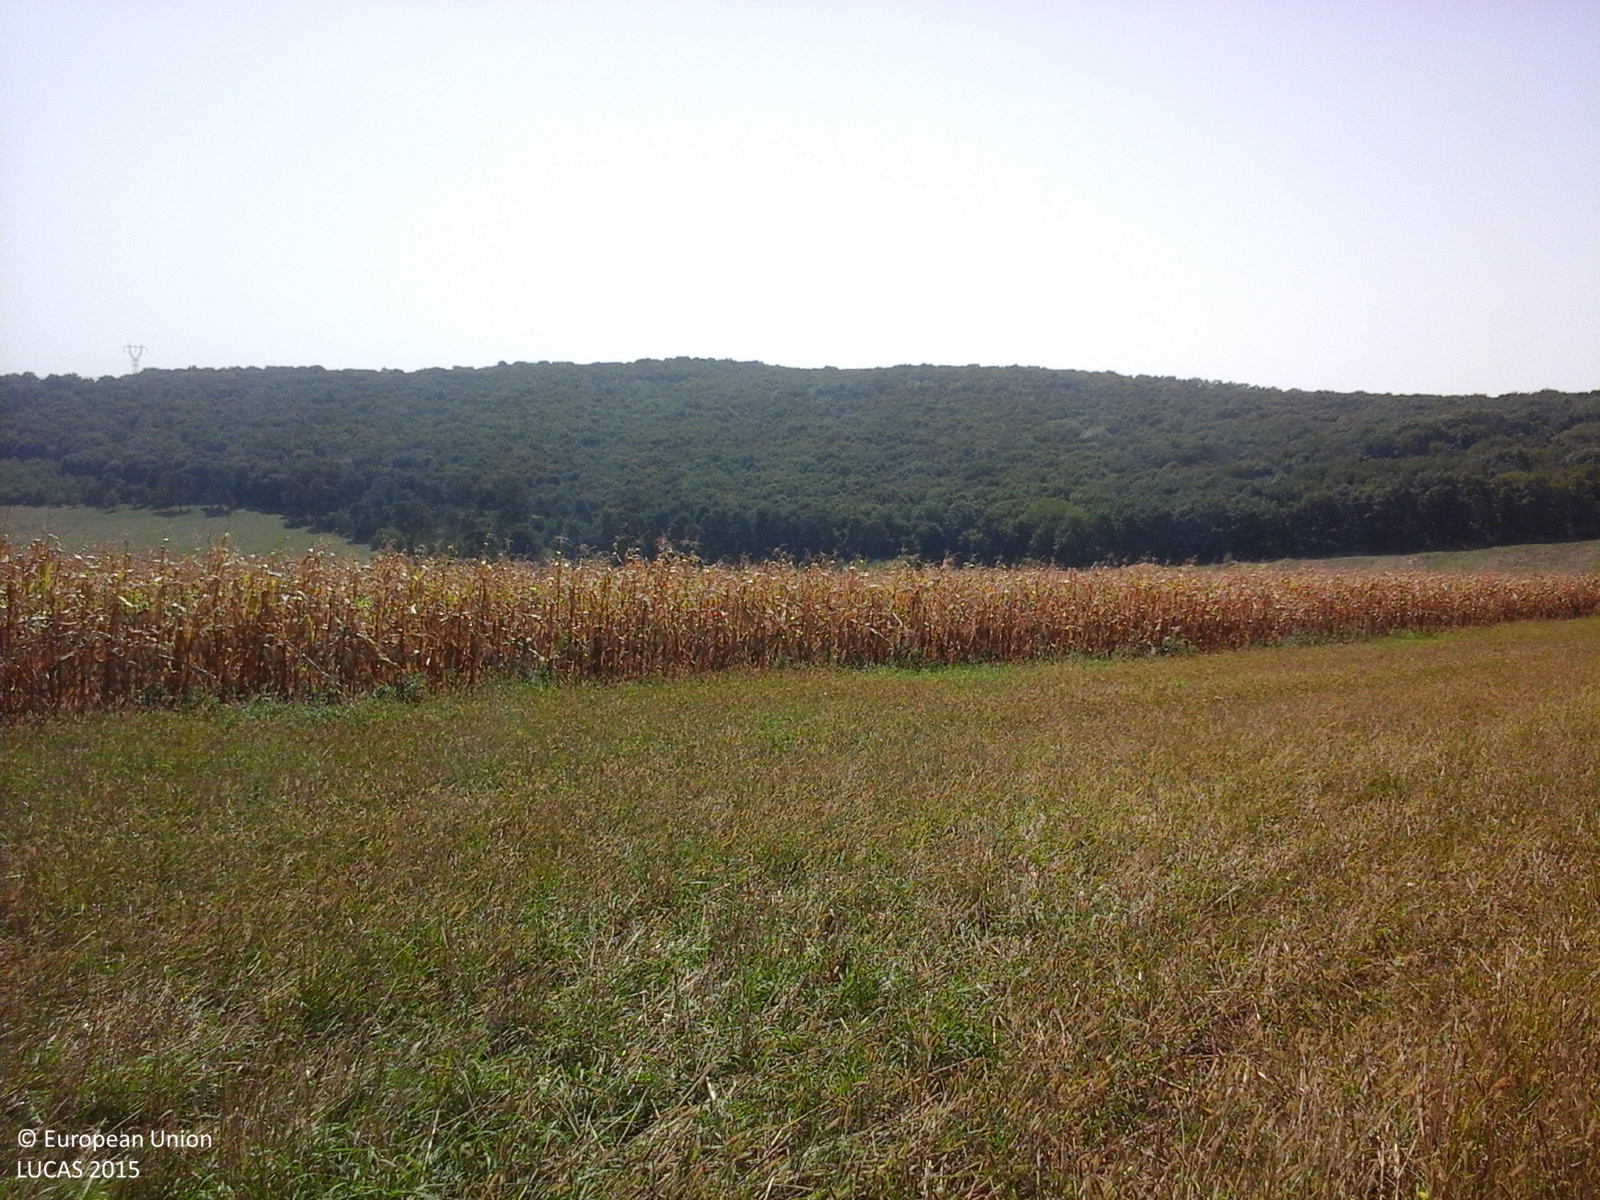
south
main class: Grassland
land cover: Grassland without tree/shrub cover
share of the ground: > 75 %
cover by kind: herbaceous plants 100 %
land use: Agriculture (excluding fallow land and kitchen gardens)
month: September
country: RO
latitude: 46.7420
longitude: 24.1247
